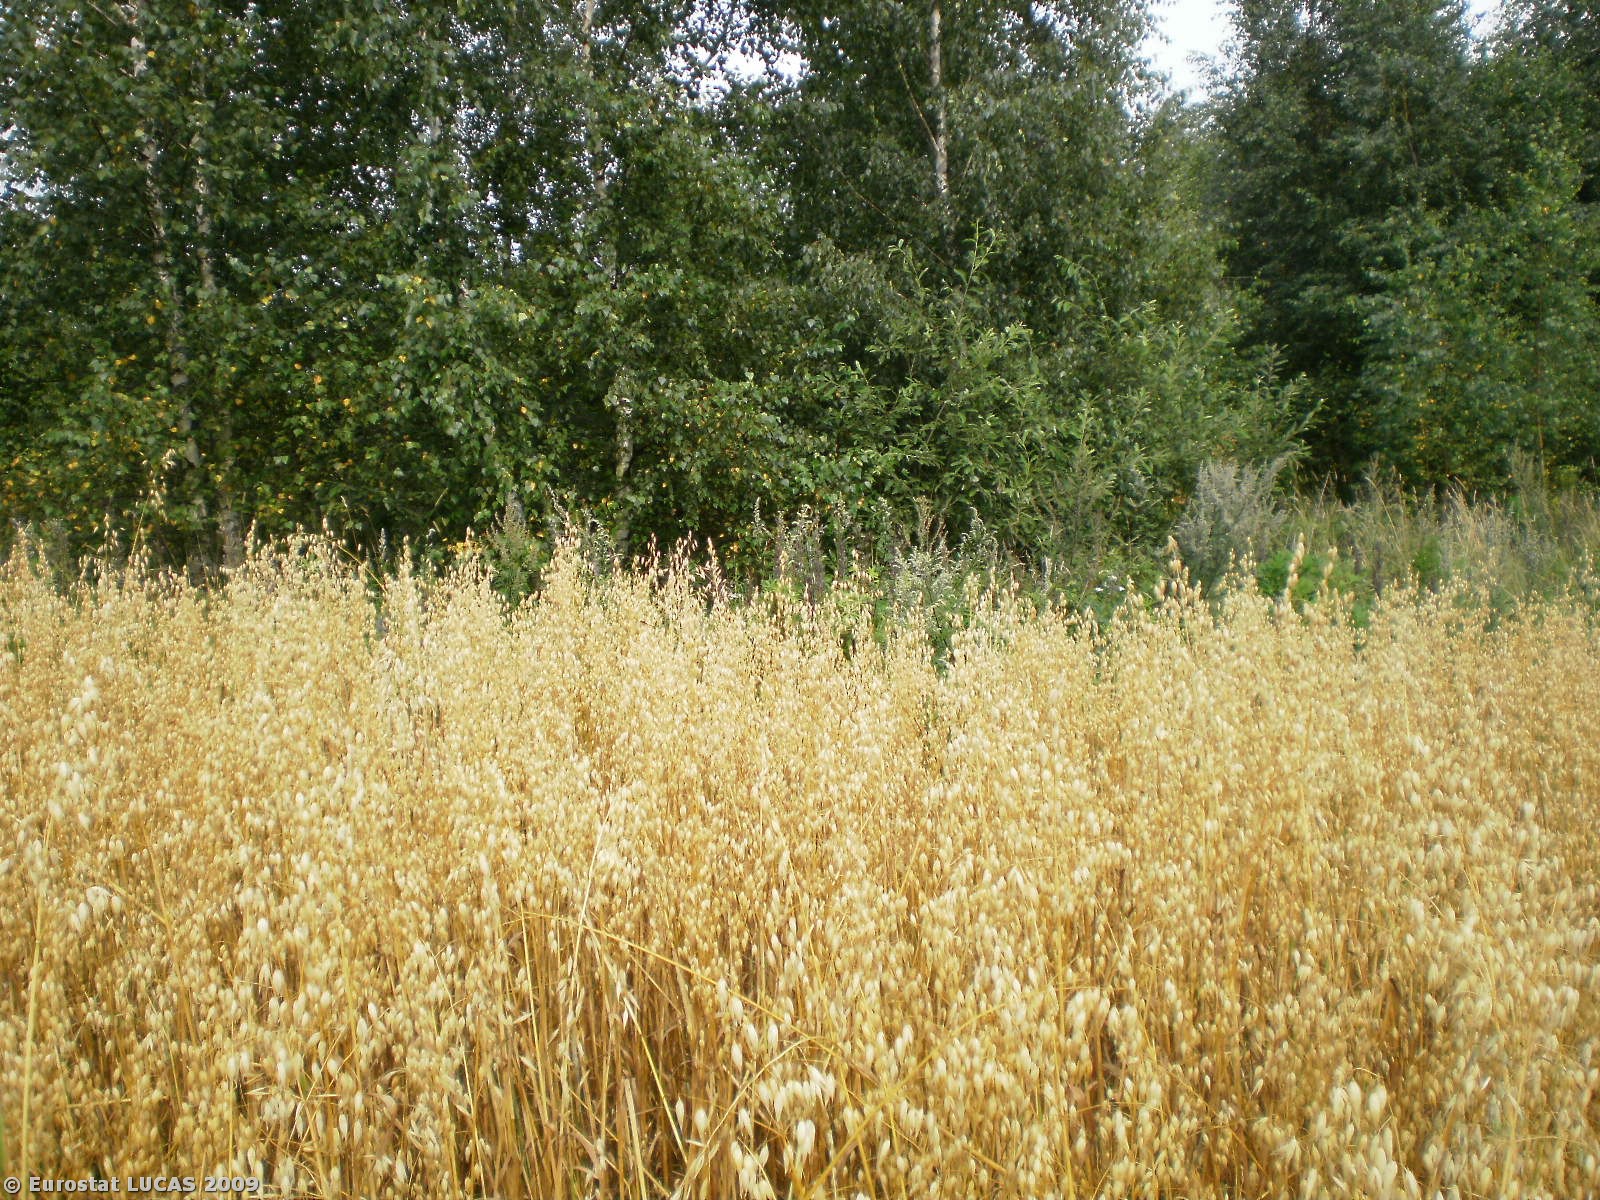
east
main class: Cropland
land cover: Oats
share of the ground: > 75 %
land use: Agriculture (excluding fallow land and kitchen gardens)
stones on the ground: < 10 %
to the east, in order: Oats; Broadleaved woodland; Grassland with sparse tree/shrub cover; Broadleaved woodland; Grassland with sparse tree/shrub cover; Grassland without tree/shrub cover
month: August
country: PL
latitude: 54.1288
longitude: 20.6430
